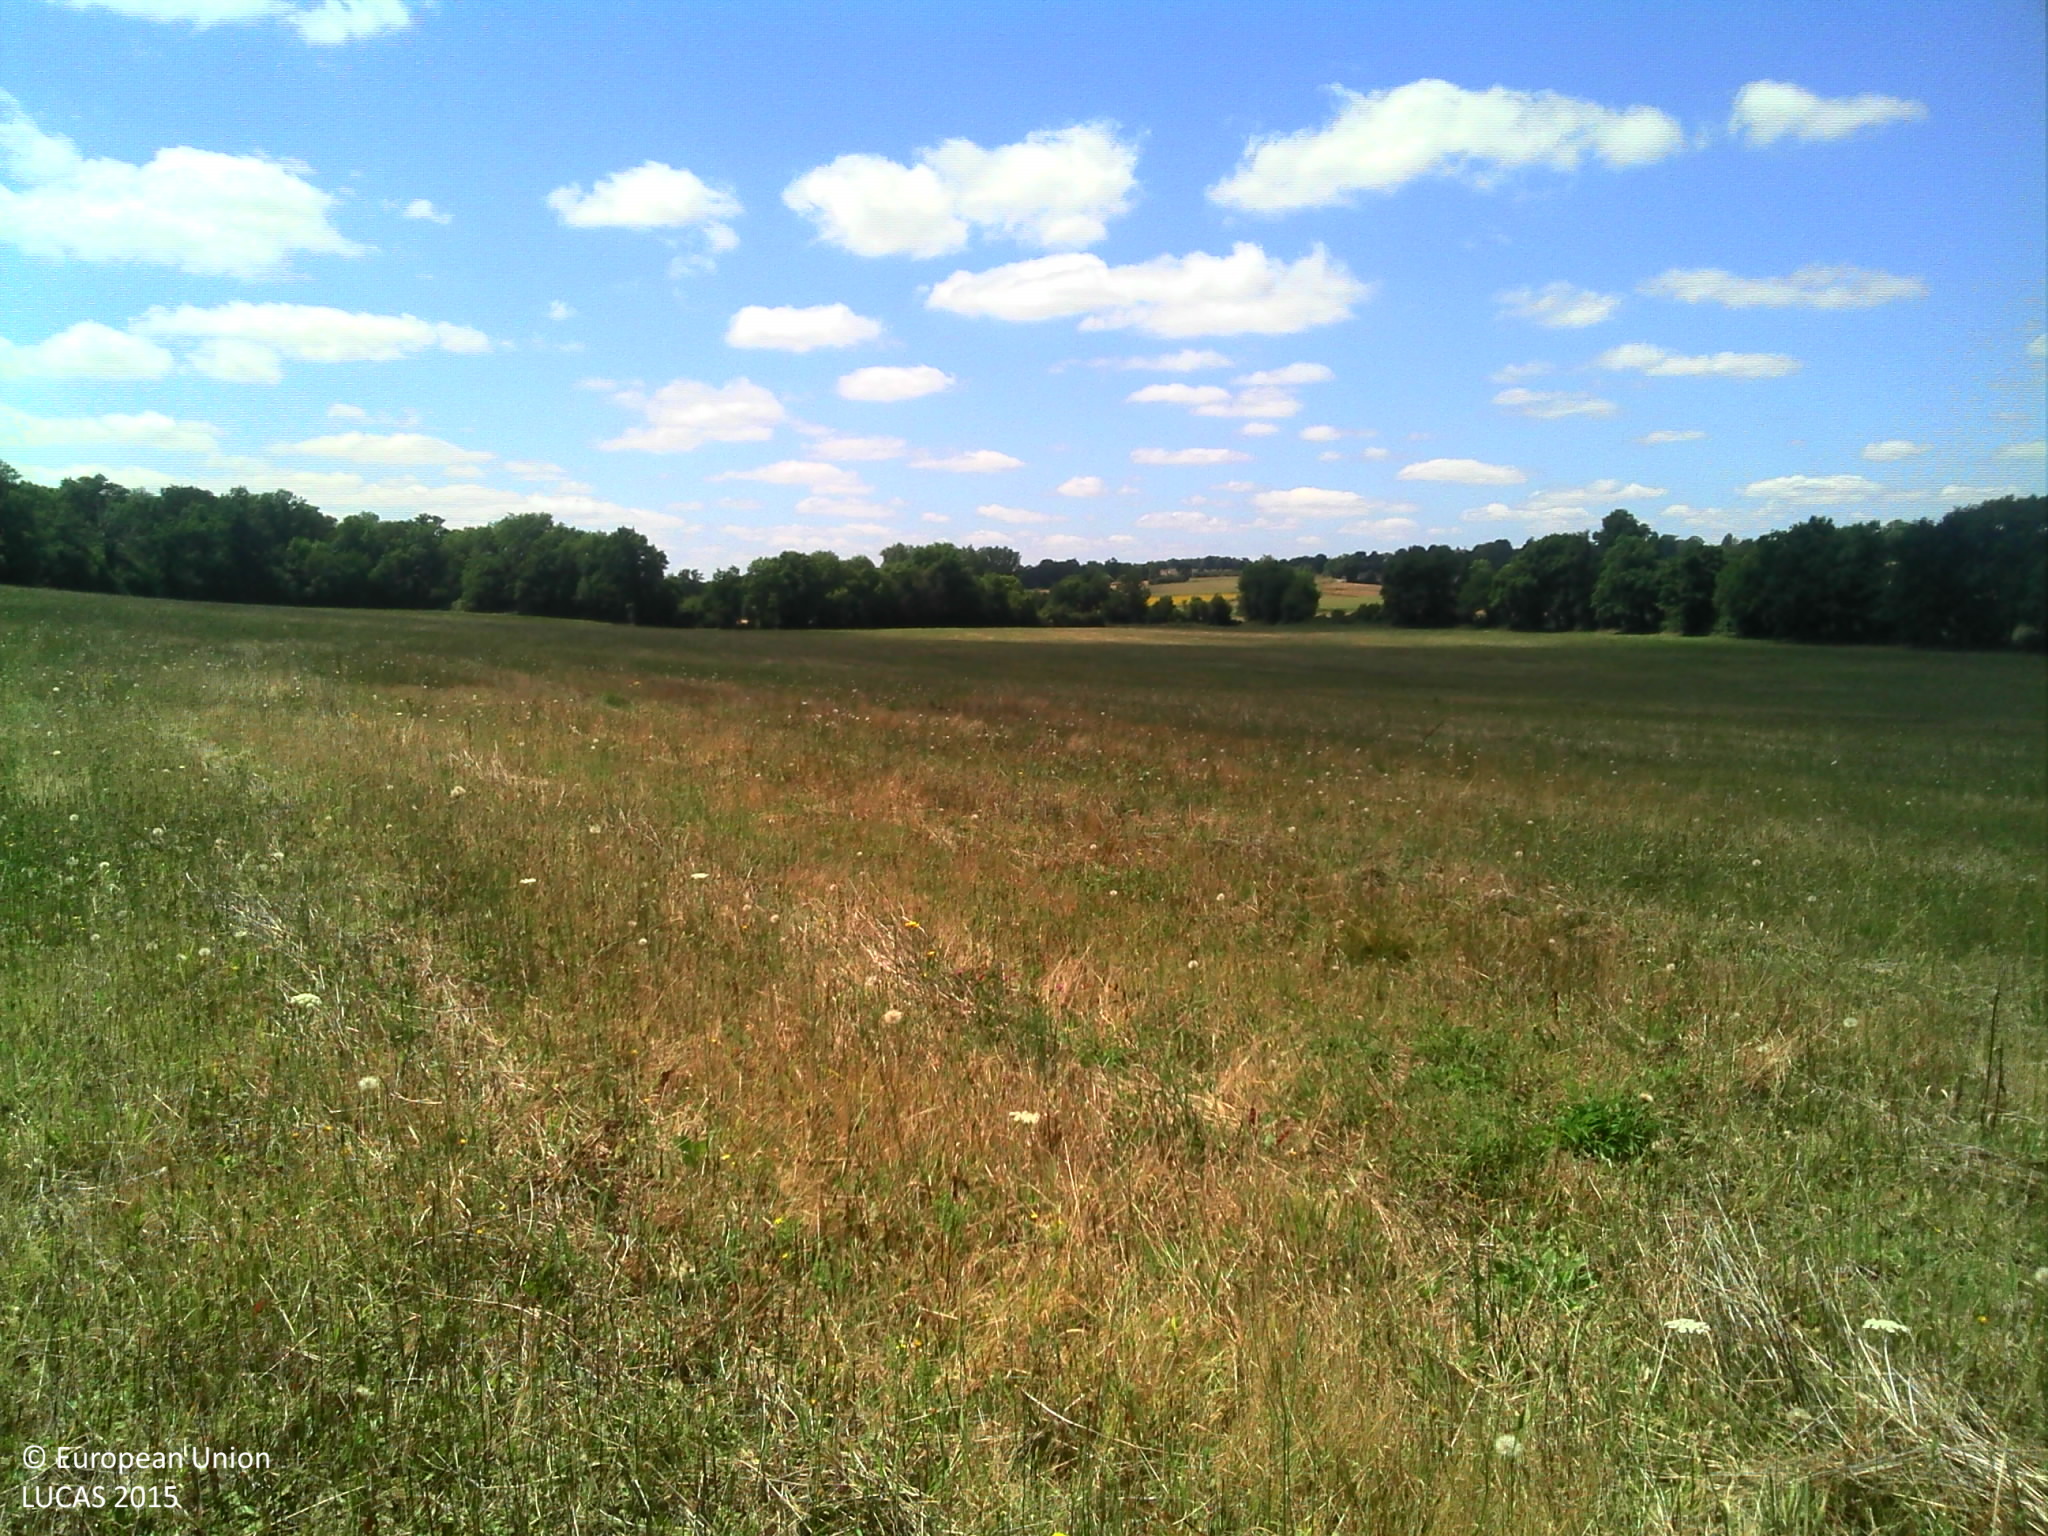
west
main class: Grassland
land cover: Grassland without tree/shrub cover
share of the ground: > 75 %
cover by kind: herbaceous plants 100 %
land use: Agriculture (excluding fallow land and kitchen gardens)
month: July
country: FR
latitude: 43.2471
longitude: 0.7517
